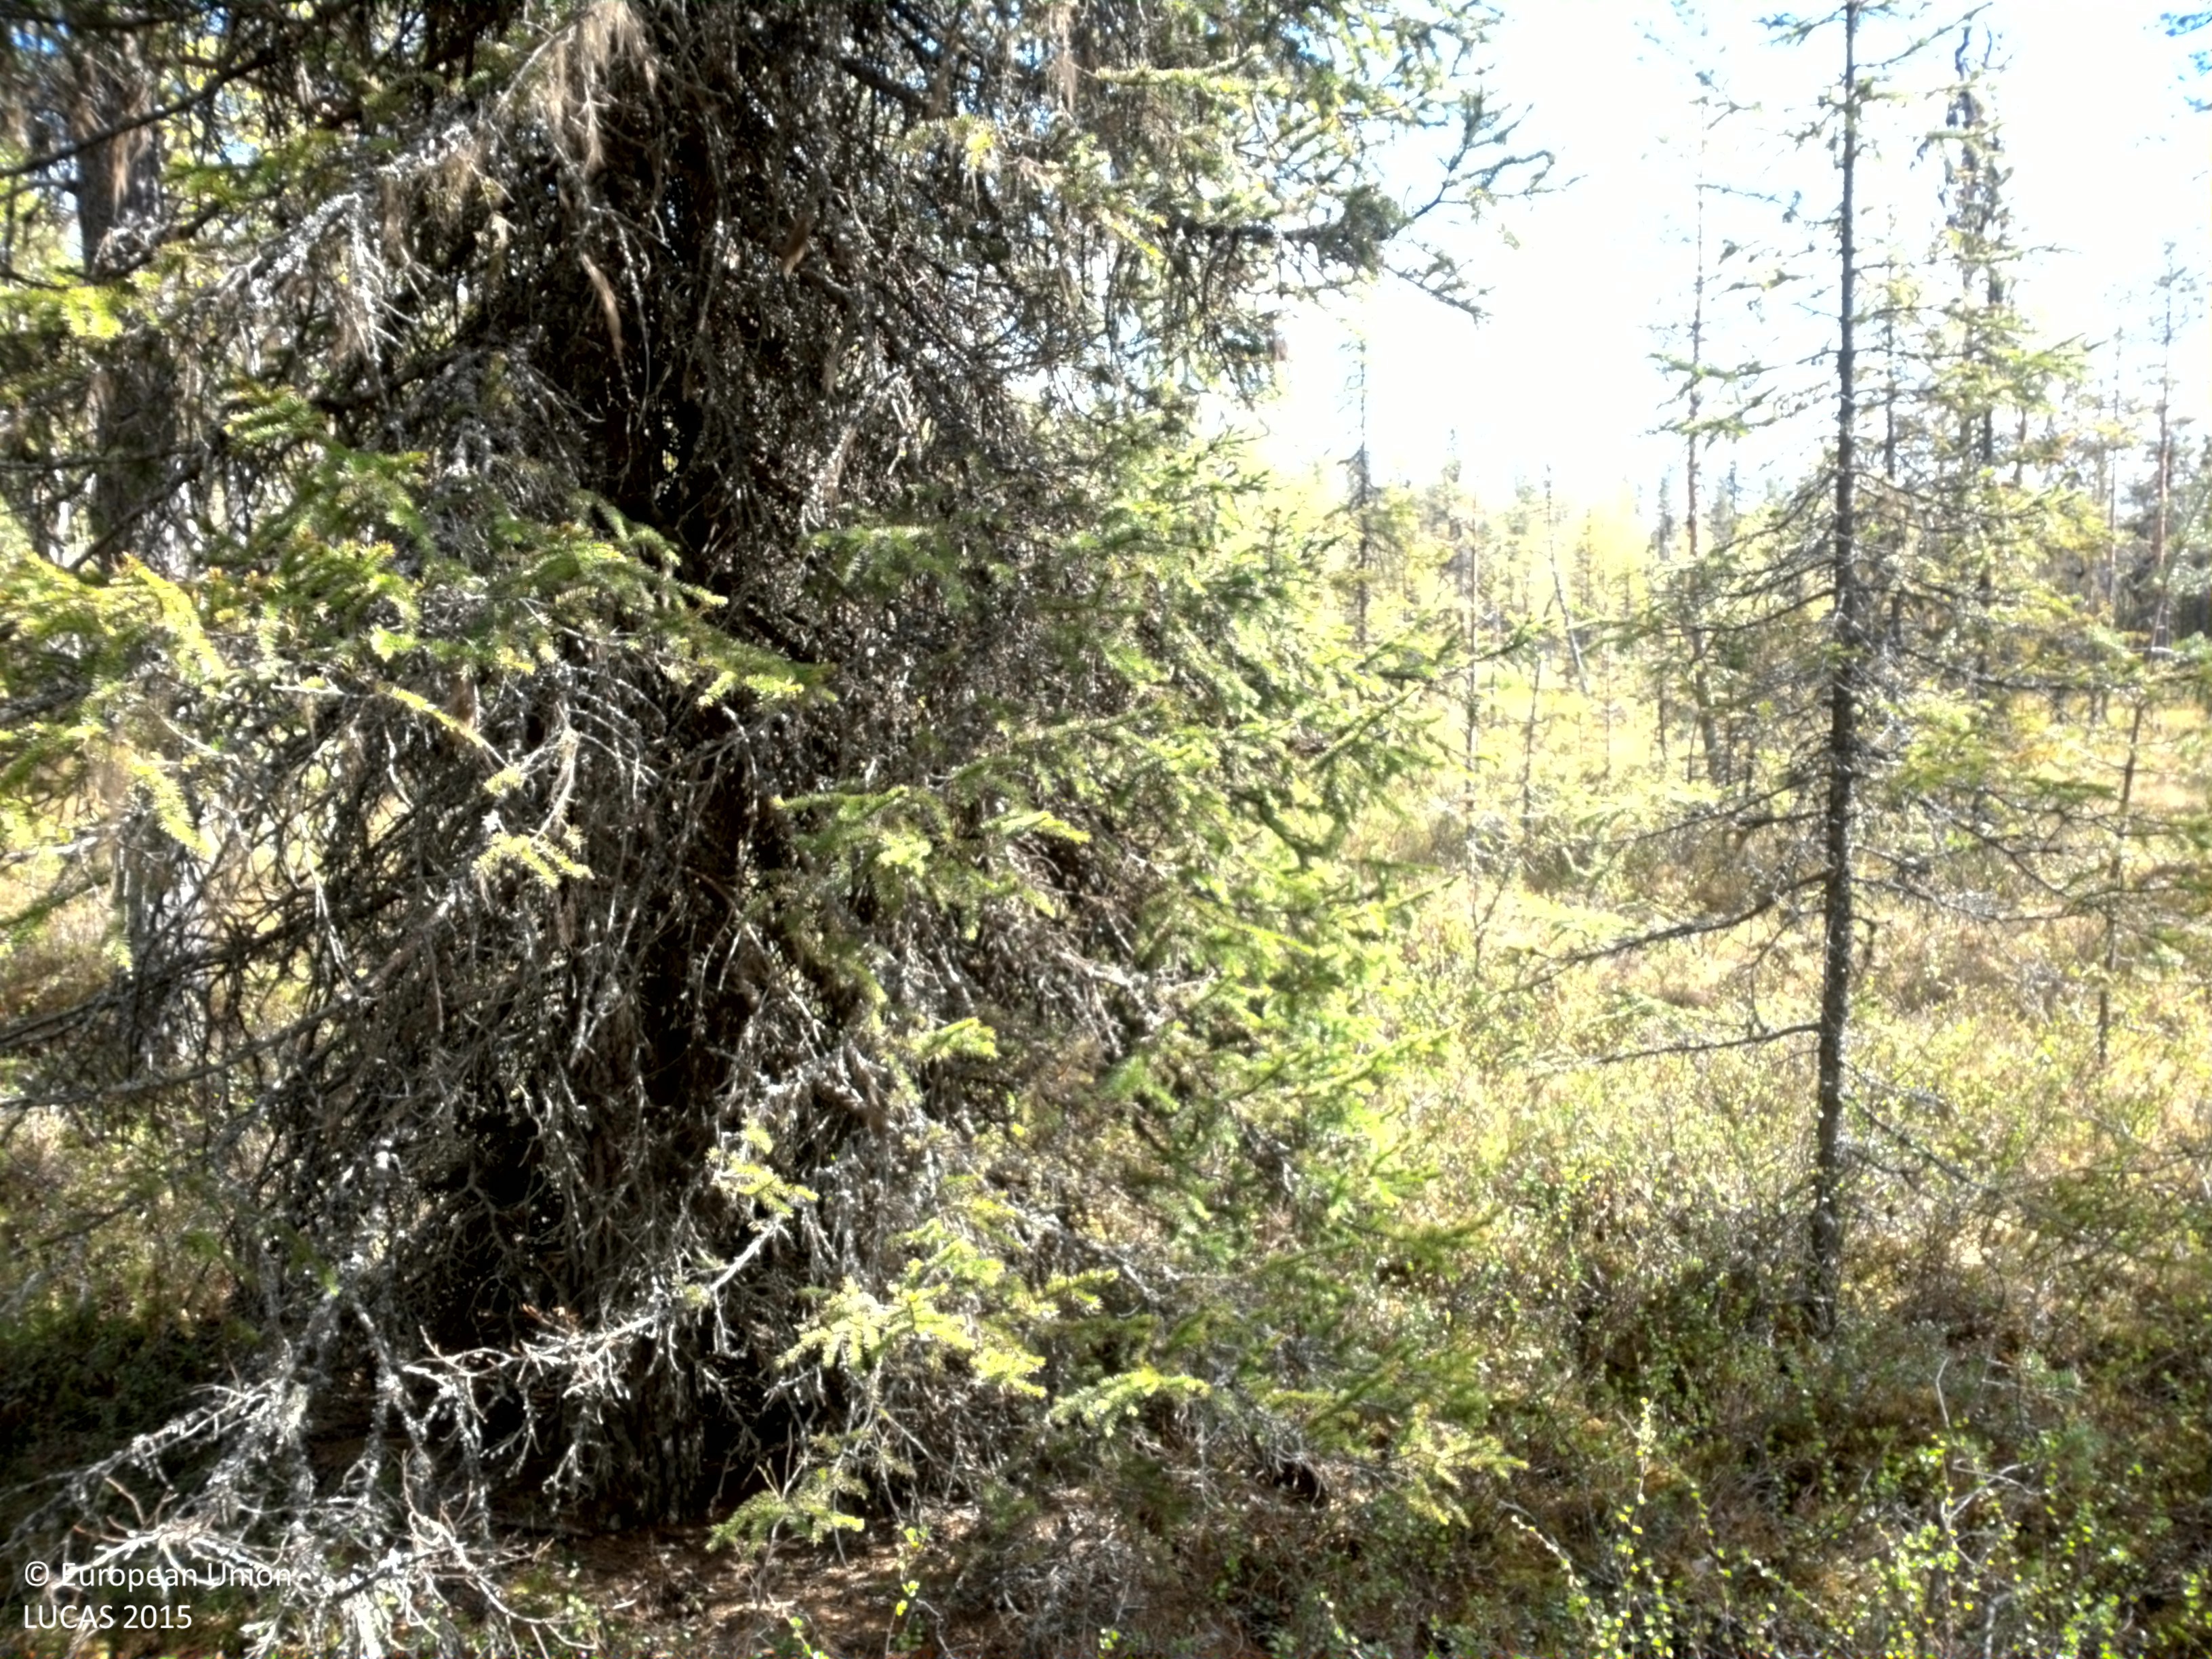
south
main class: Woodland
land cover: Pine dominated mixed woodland
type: boreal forest
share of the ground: 25 - 50 %
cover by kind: coniferous forest trees 35 %, shrubs 25 %, broadleaved forest trees 15 %, lichens and mosses 15 %, herbaceous plants 10 %
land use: Forestry
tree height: > 5 m
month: June
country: SE
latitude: 64.2890
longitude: 17.5920
